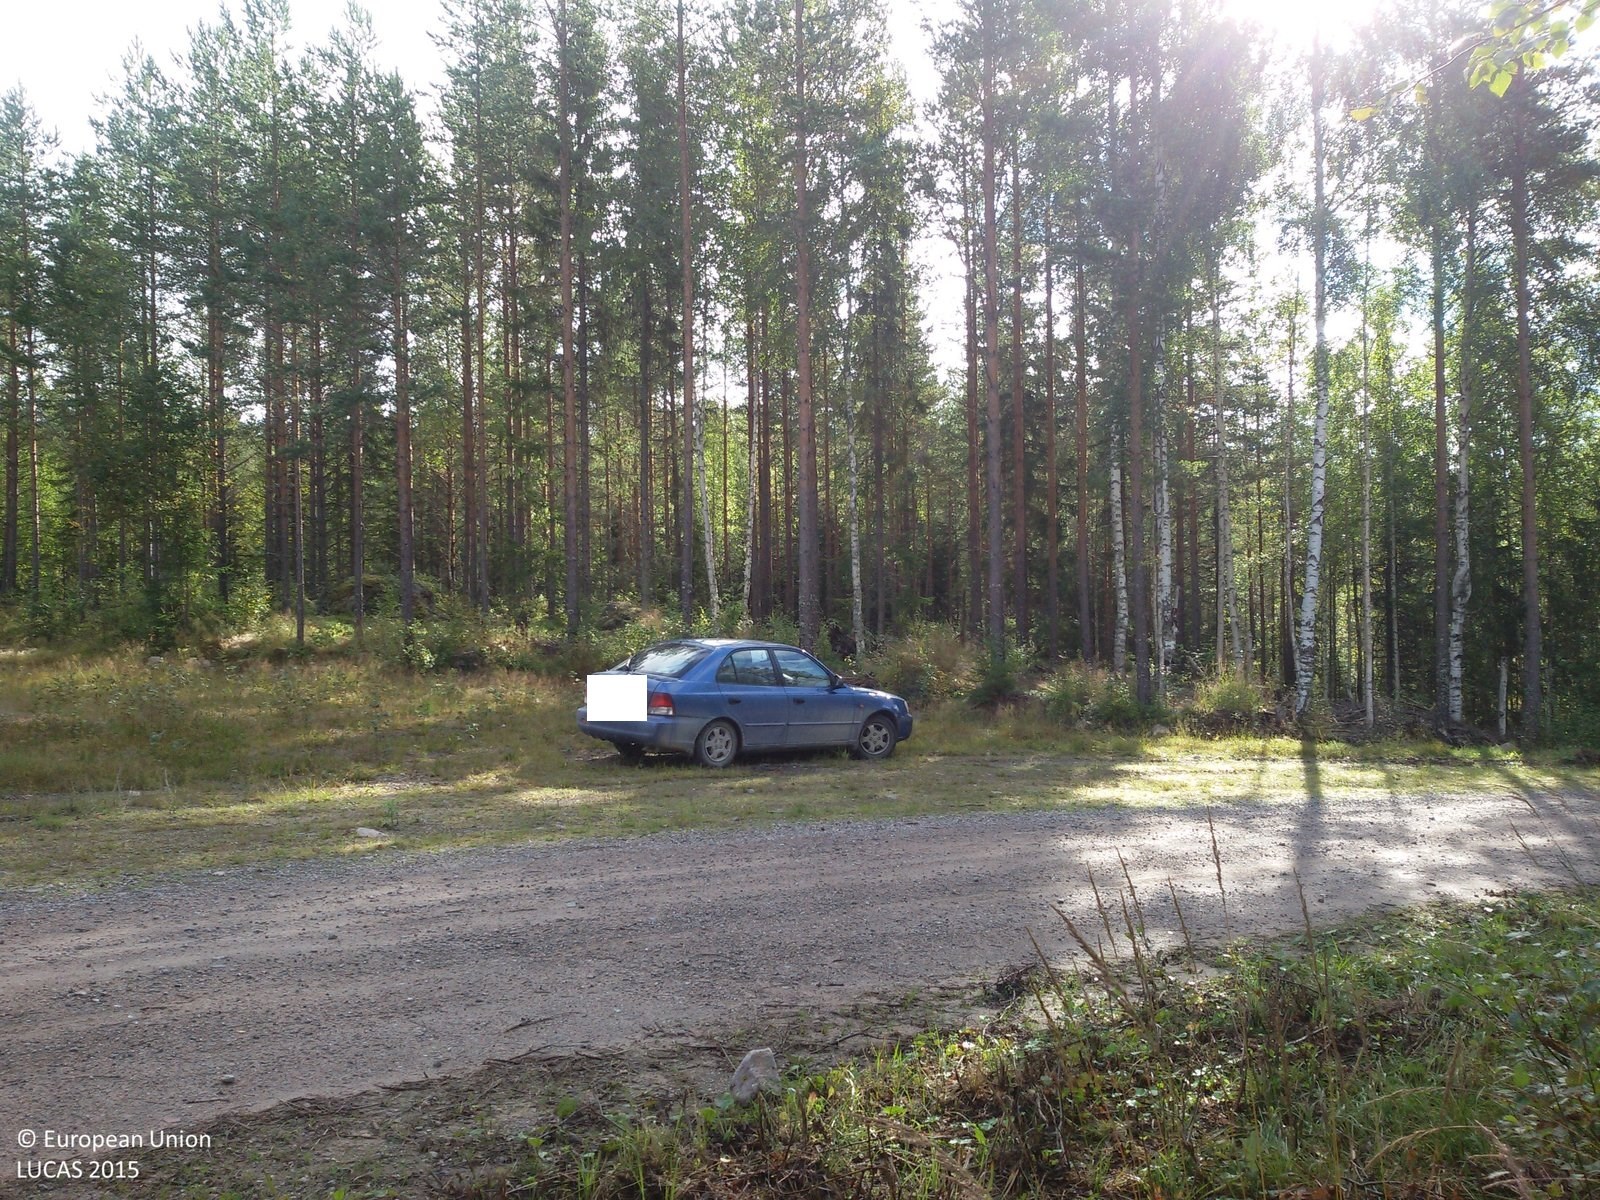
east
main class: Woodland
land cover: Spruce dominated mixed woodland
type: boreal forest
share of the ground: 50 - 75 %
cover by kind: broadleaved forest trees 40 %, coniferous forest trees 30 %, herbaceous plants 30 %
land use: Forestry
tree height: > 5 m
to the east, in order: Spruce dominated mixed woodland; Paved roads, cycling and walking lanes; Pine dominated coniferous woodland; Spruce dominated mixed woodland; Pine dominated coniferous woodland
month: September
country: SE
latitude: 61.0517
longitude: 15.4123
